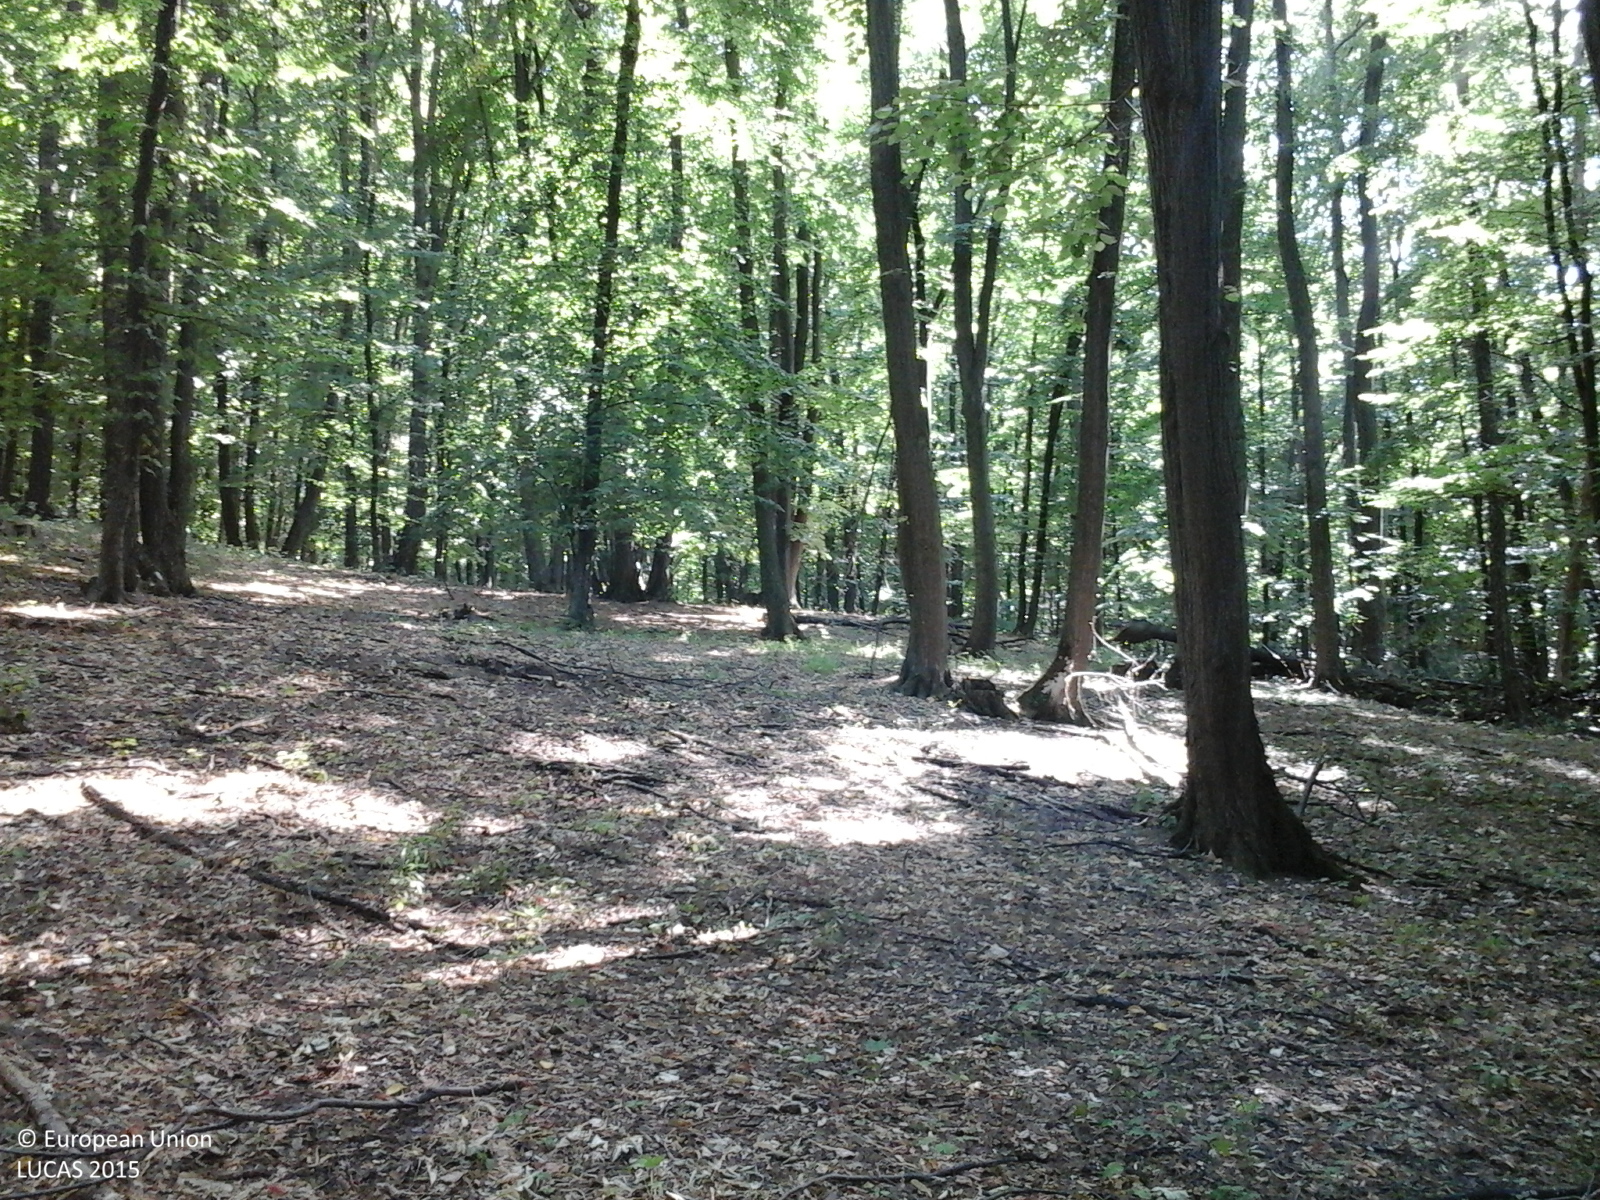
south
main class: Woodland
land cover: Broadleaved woodland
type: beech forest
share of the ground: > 75 %
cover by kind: broadleaved forest trees 100 %
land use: Forestry
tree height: > 5 m
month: June
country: RO
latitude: 46.9968
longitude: 27.9203
